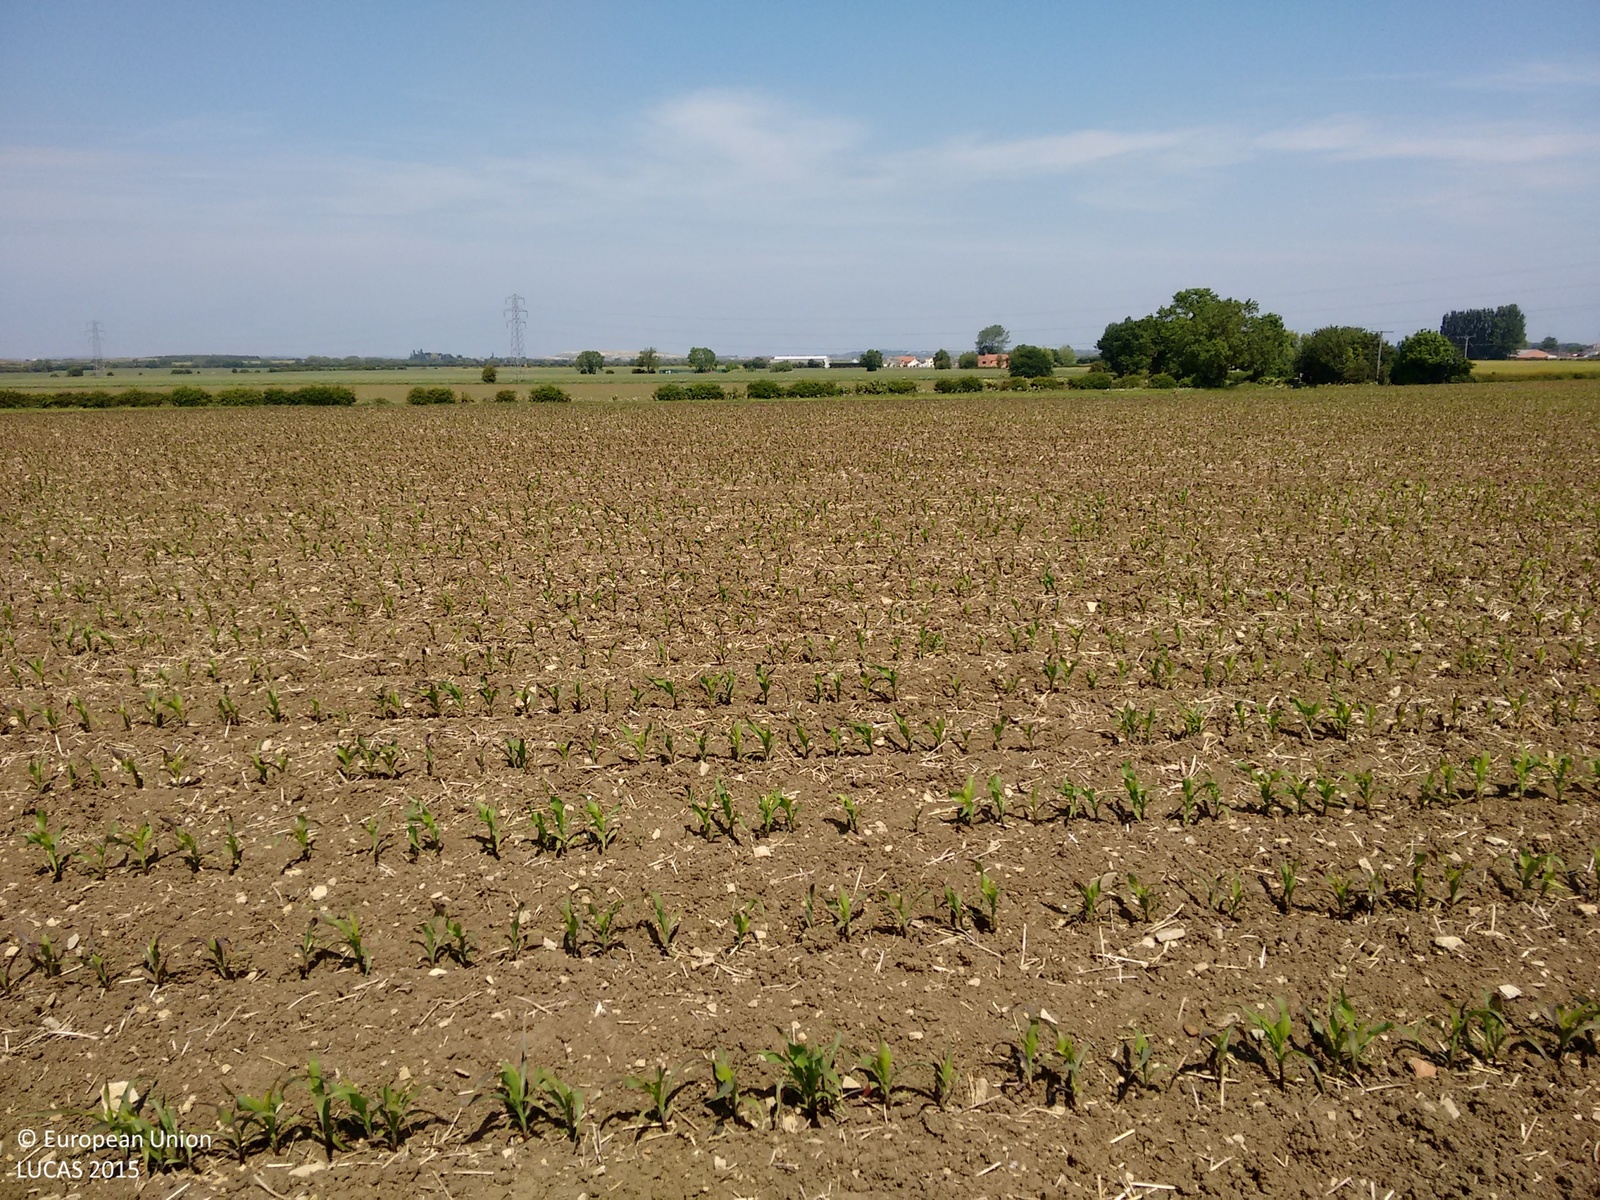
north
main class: Cropland
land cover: Maize
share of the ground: 10 - 25 %
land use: Agriculture (excluding fallow land and kitchen gardens)
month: June
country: GB
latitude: 53.0093
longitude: -0.7868
